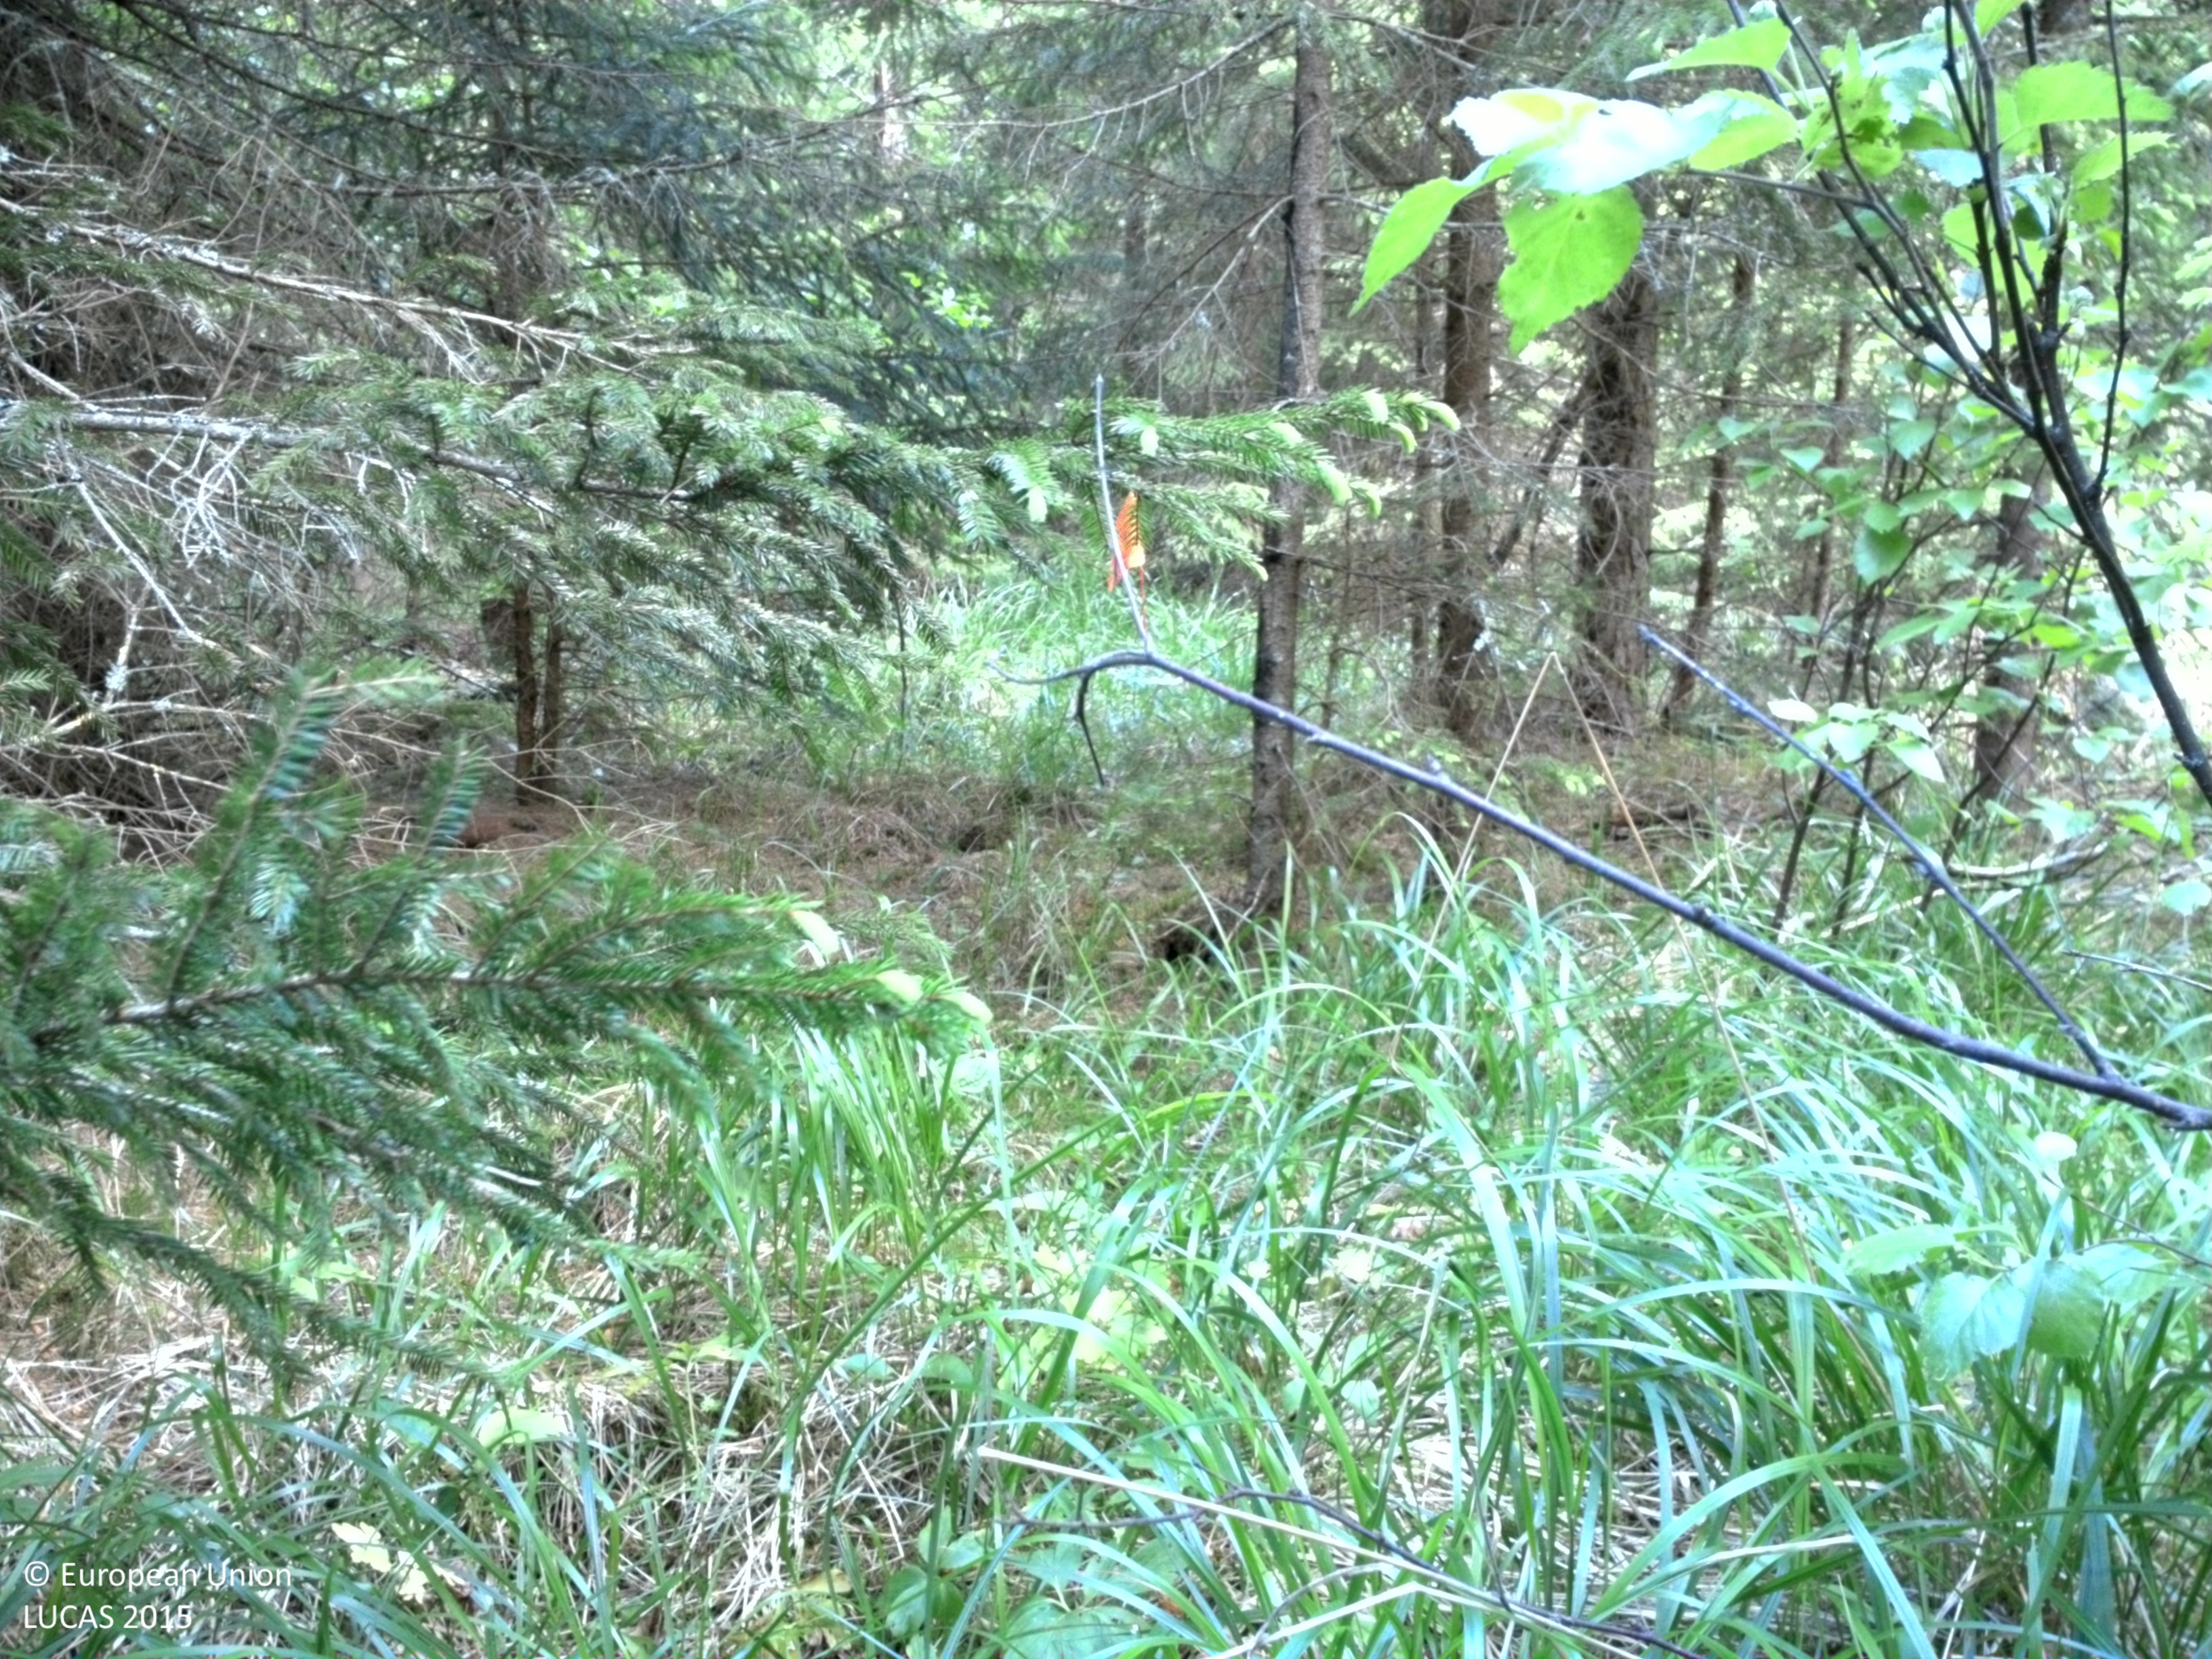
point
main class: Woodland
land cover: Spruce dominated mixed woodland
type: boreal forest
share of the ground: 50 - 75 %
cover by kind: coniferous forest trees 50 %, herbaceous plants 25 %, broadleaved forest trees 20 %, lichens and mosses 5 %
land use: Forestry
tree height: > 5 m
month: June
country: SE
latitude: 60.2393
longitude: 17.0525
